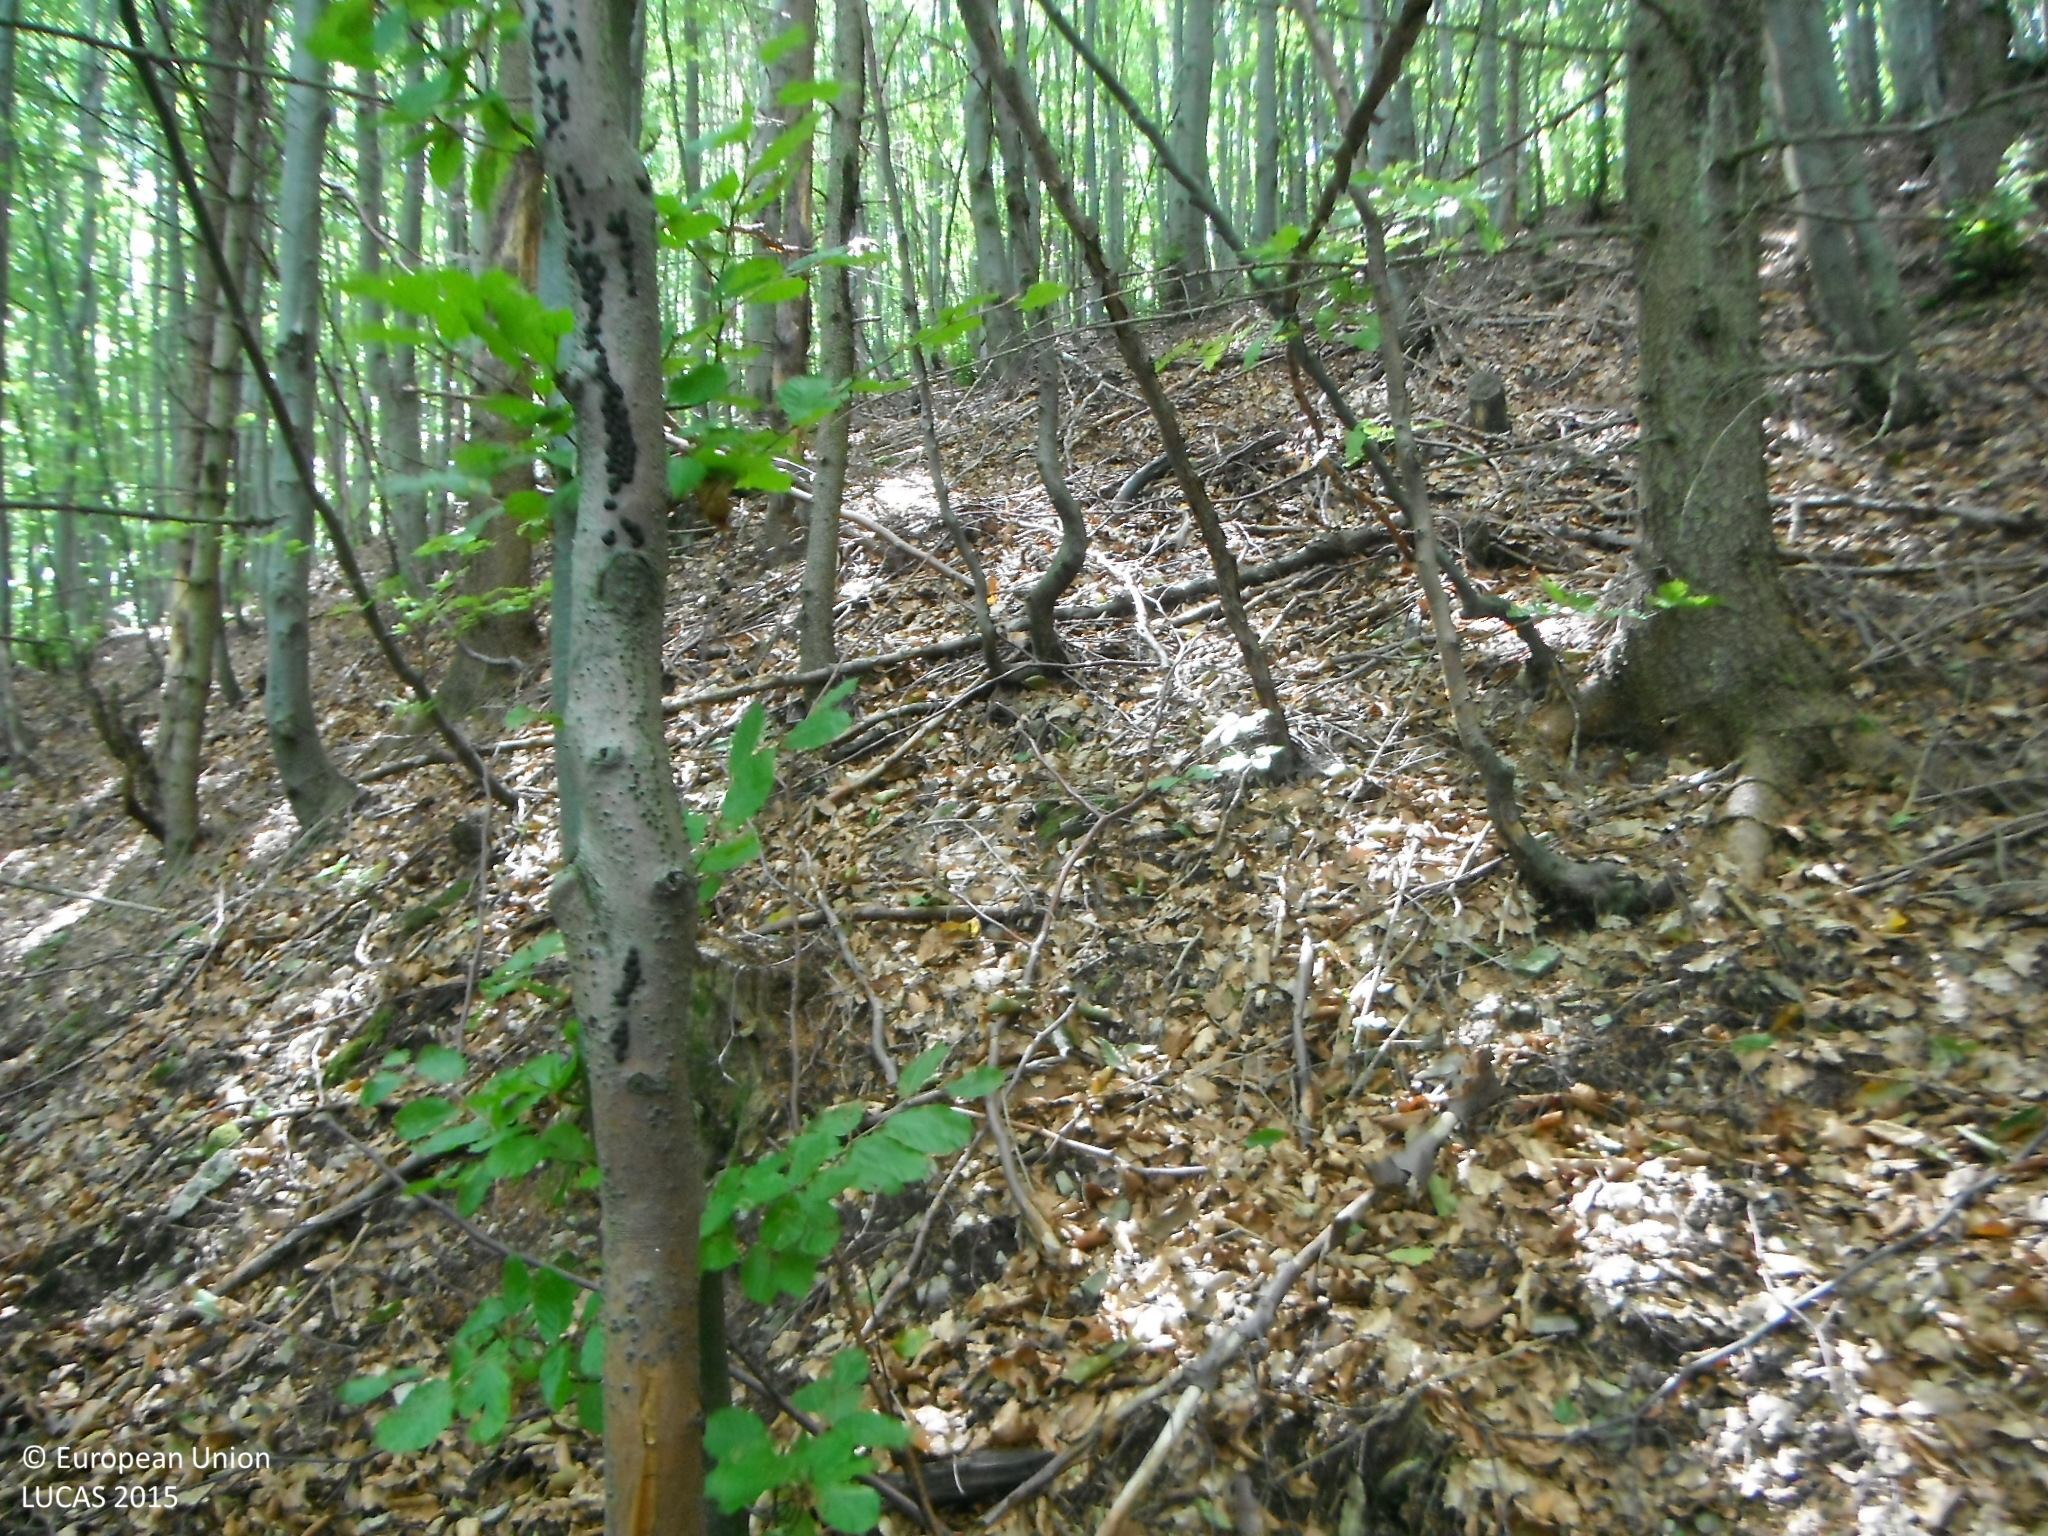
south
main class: Woodland
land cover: Broadleaved woodland
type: mountainous beech forest
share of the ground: > 75 %
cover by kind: broadleaved forest trees 95 %
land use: Forestry
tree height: > 5 m
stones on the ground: 25 - 50 %
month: September
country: SK
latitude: 48.9065
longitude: 18.5175
